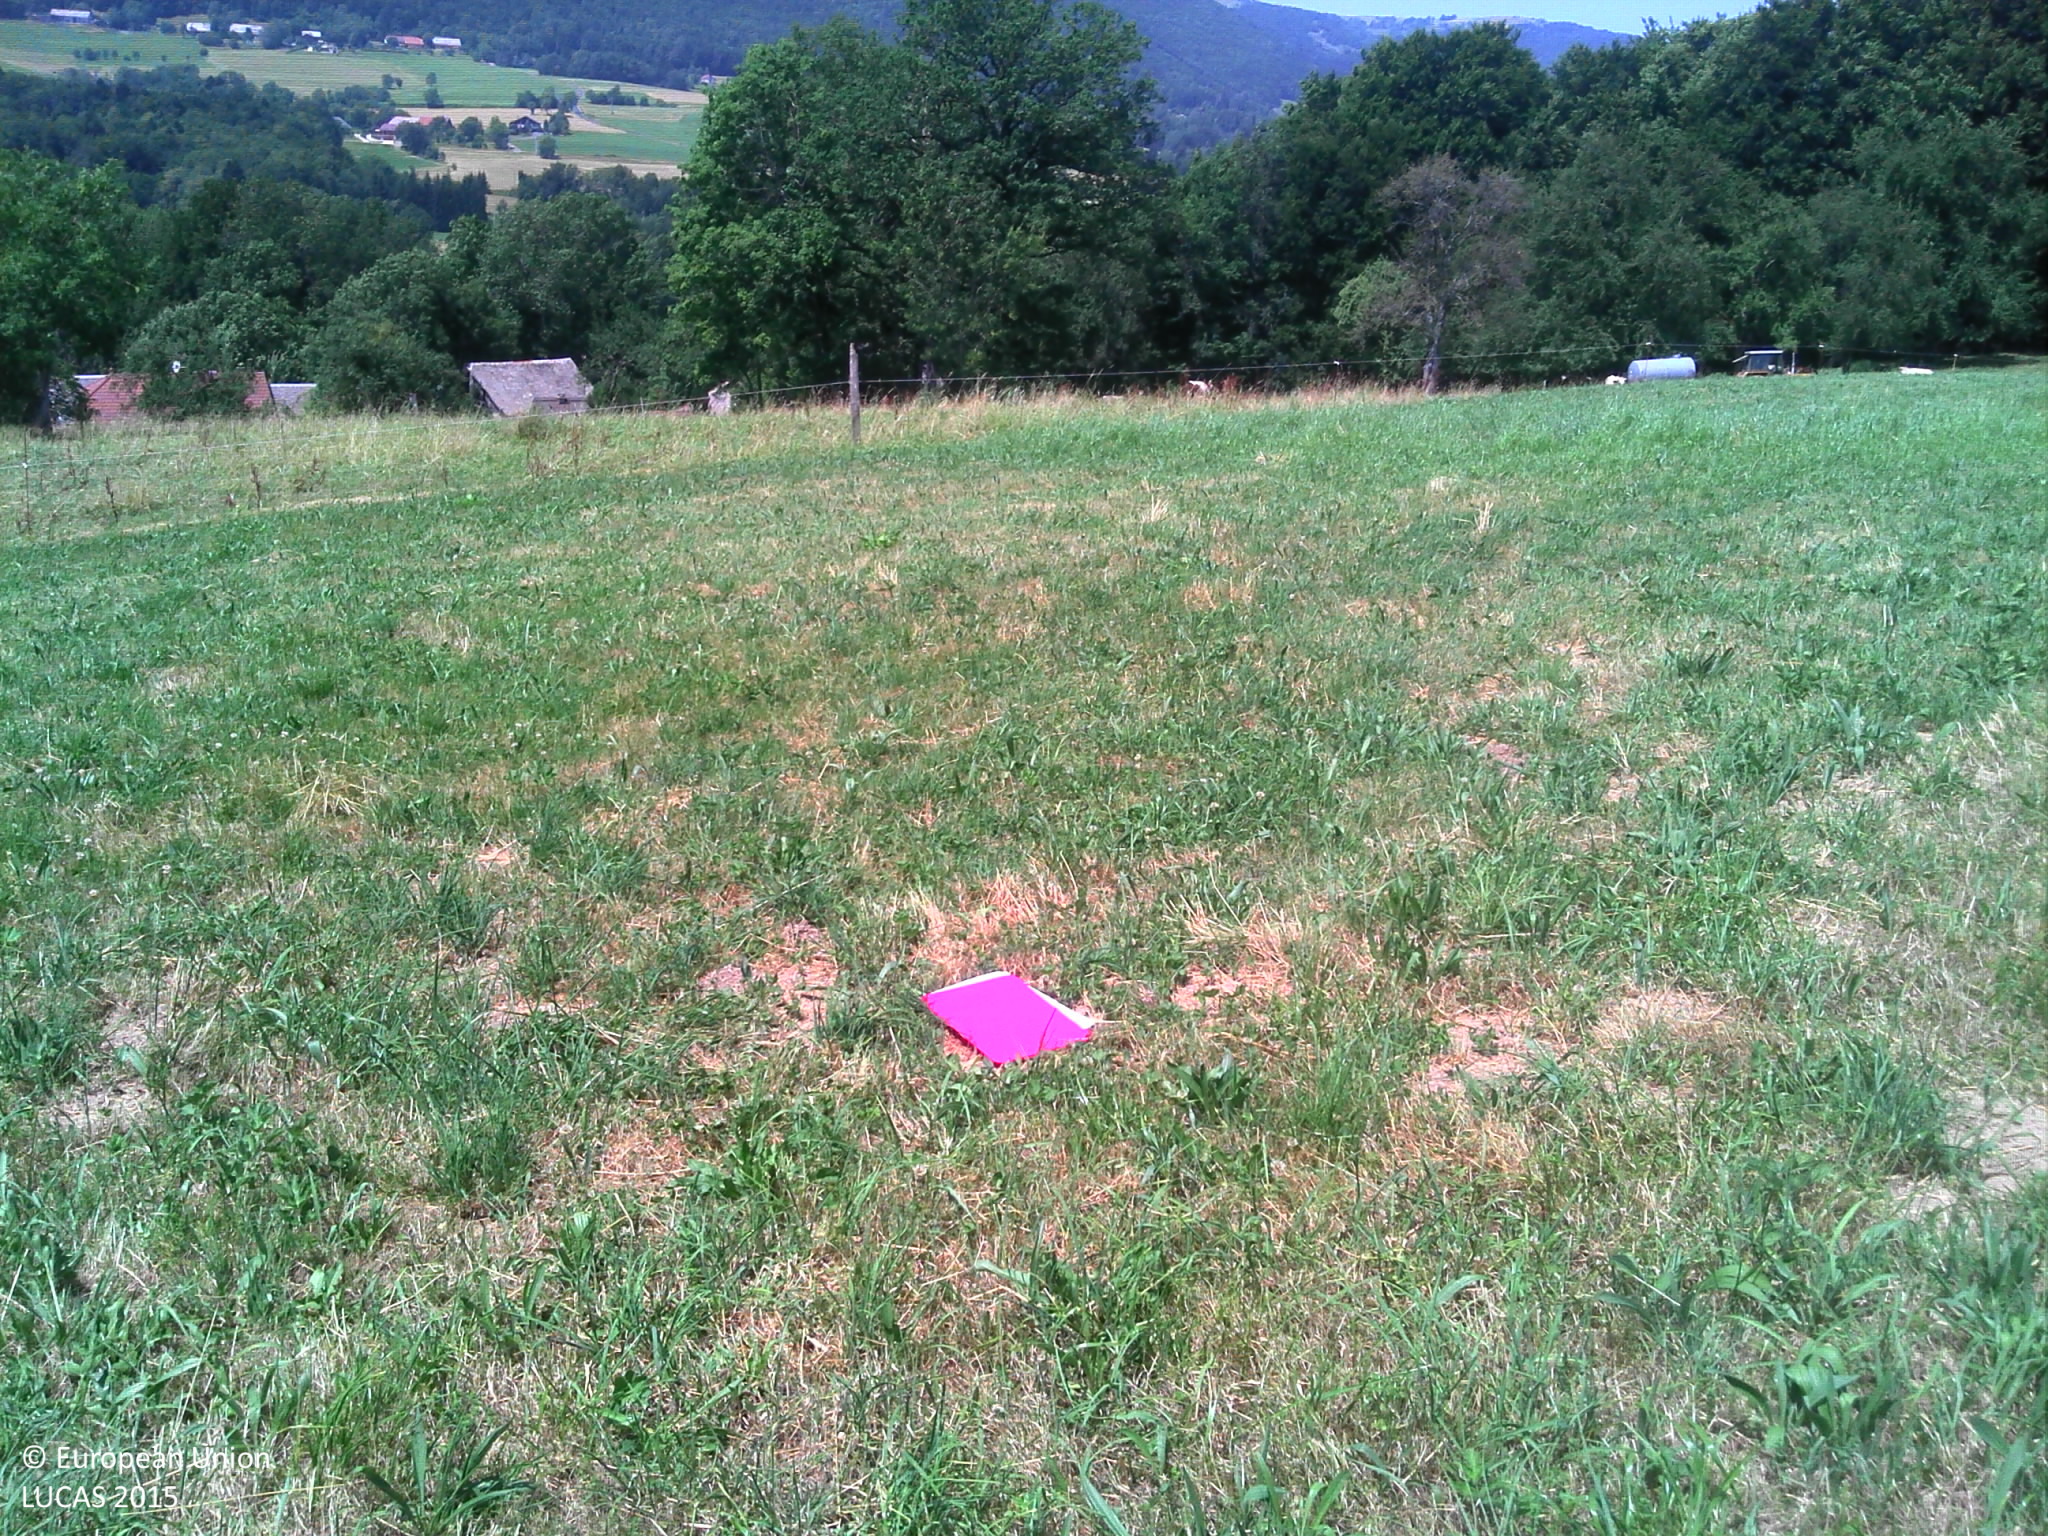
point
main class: Grassland
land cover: Grassland without tree/shrub cover
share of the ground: > 75 %
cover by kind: herbaceous plants 100 %
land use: Agriculture (excluding fallow land and kitchen gardens)
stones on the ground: < 10 %
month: July
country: FR
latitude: 46.0850
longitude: 6.1886
